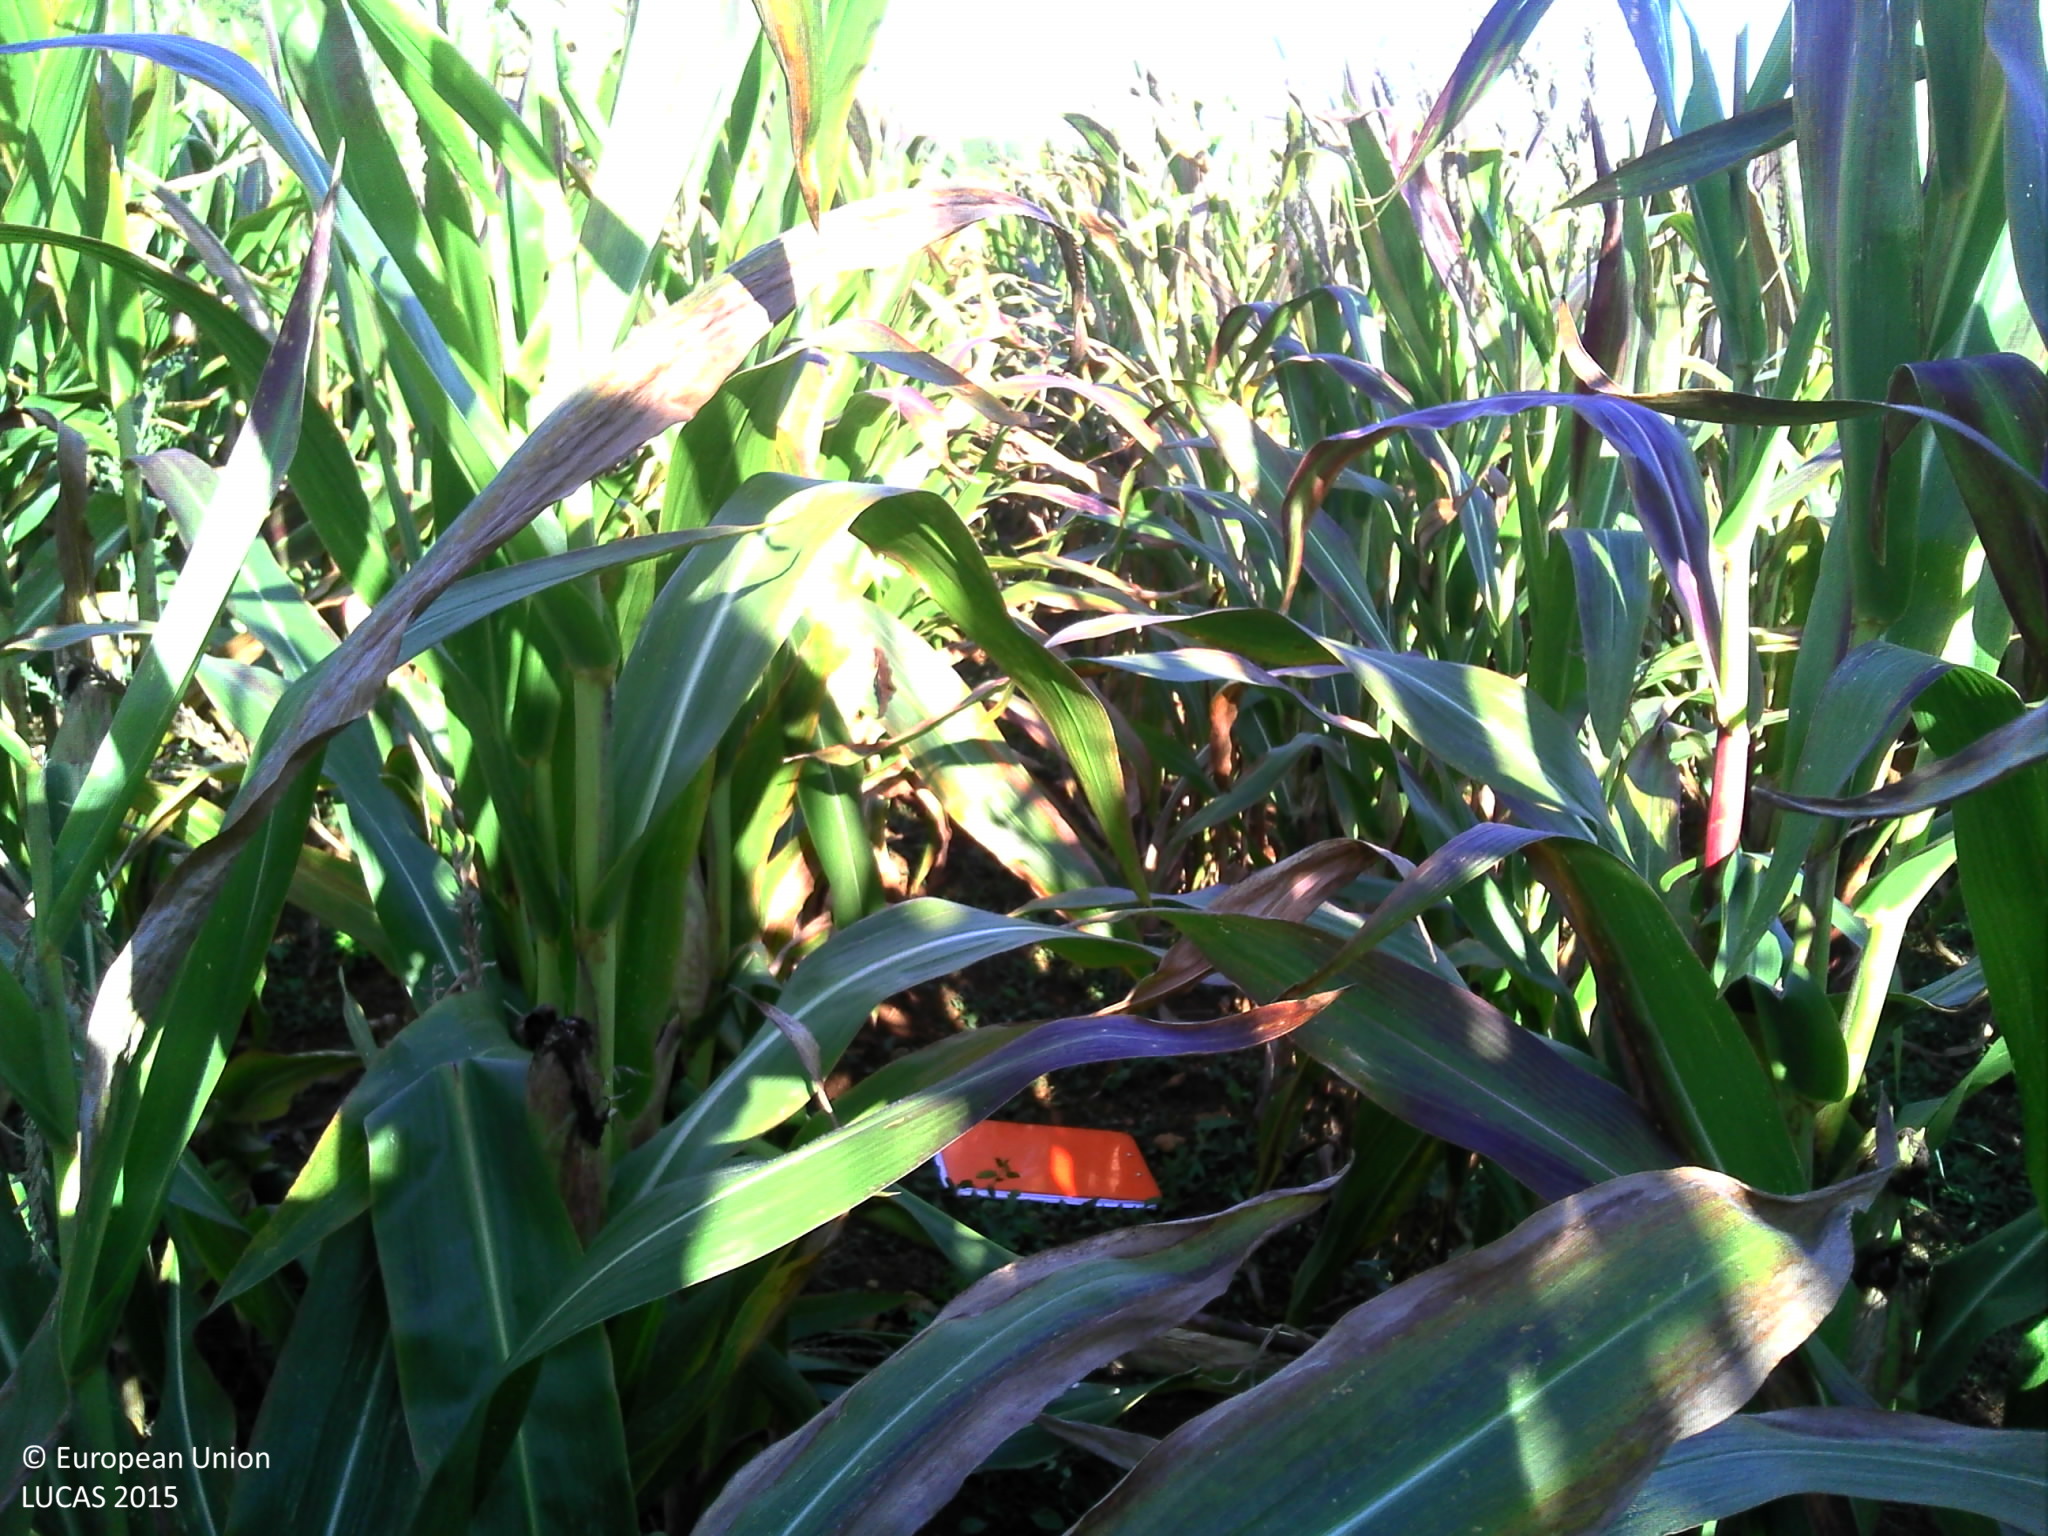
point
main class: Cropland
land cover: Maize
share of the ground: > 75 %
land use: Agriculture (excluding fallow land and kitchen gardens)
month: September
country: FR
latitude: 49.3008
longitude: 5.9149
